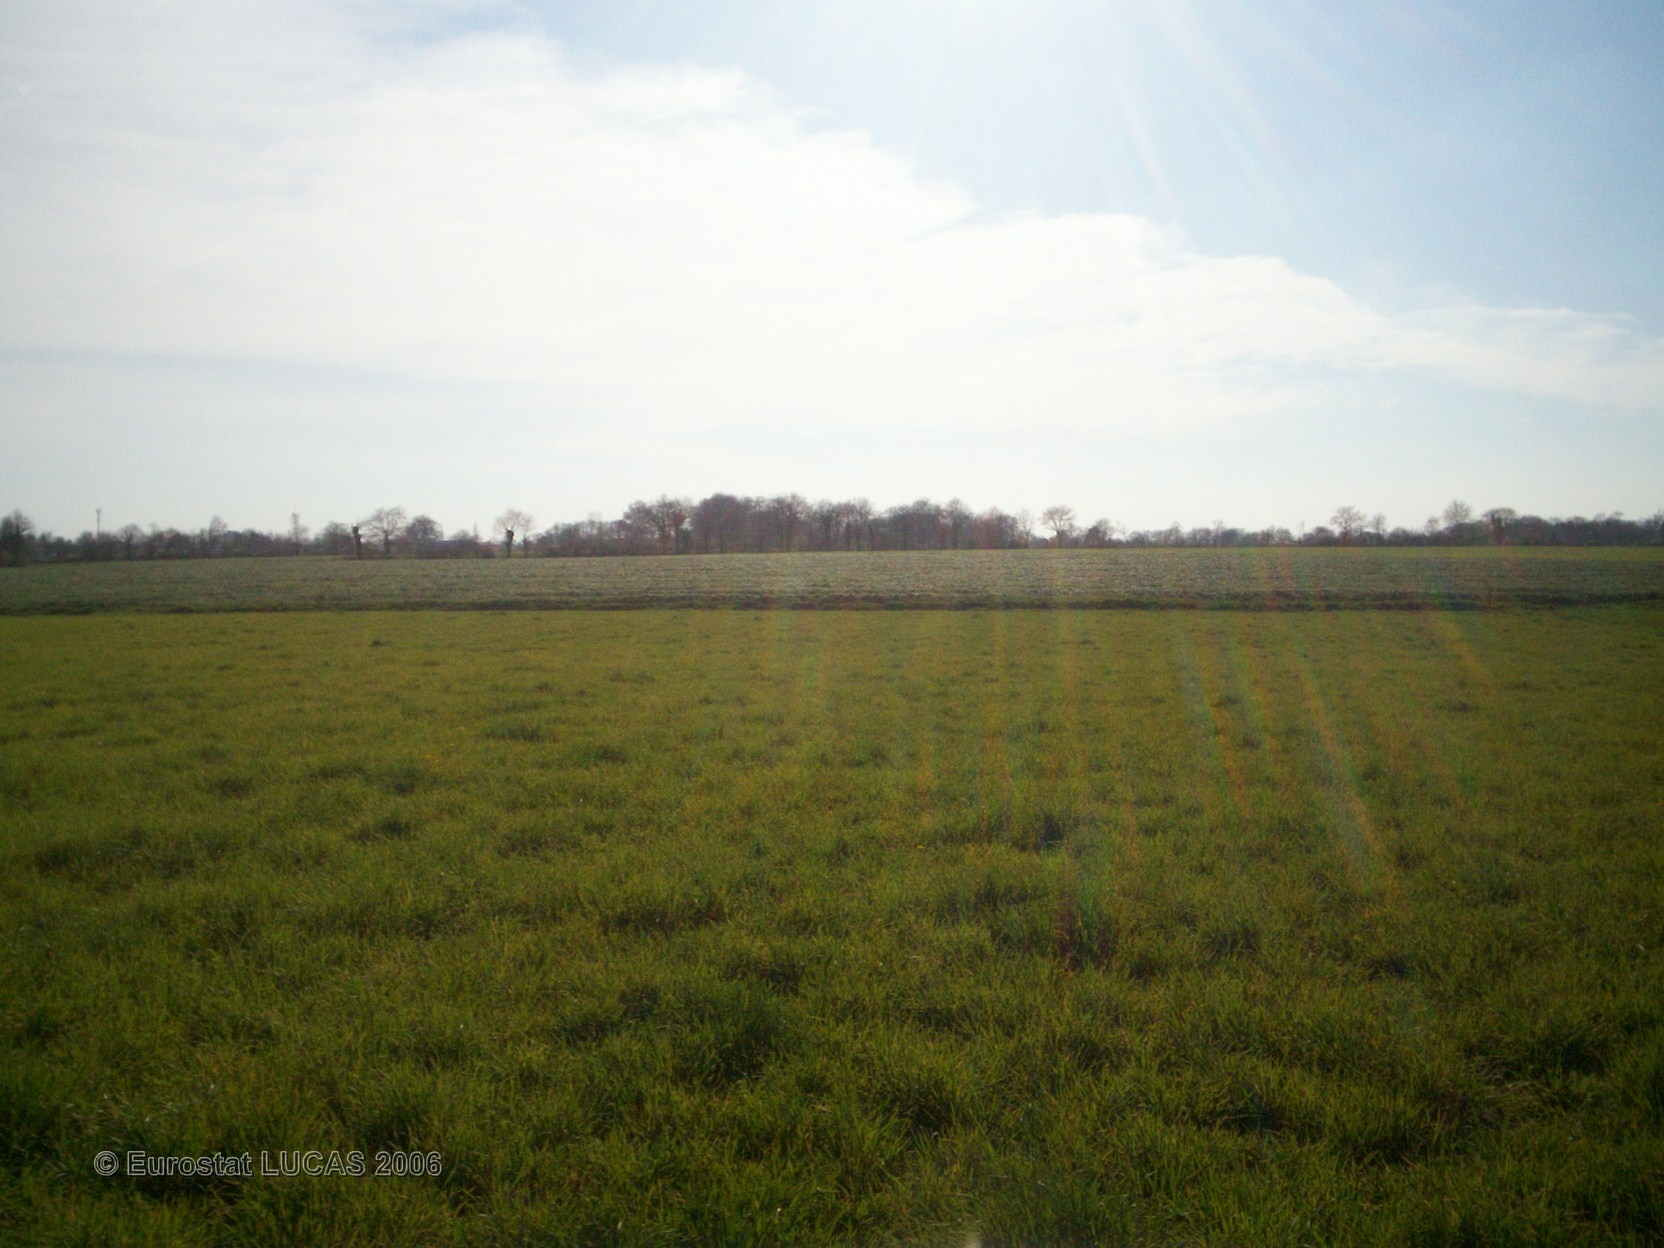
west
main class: Grassland
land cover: Grassland without tree/shrub cover
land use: Agriculture (excluding fallow land and kitchen gardens)
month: April
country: FR
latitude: 46.9530
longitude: -1.2717
